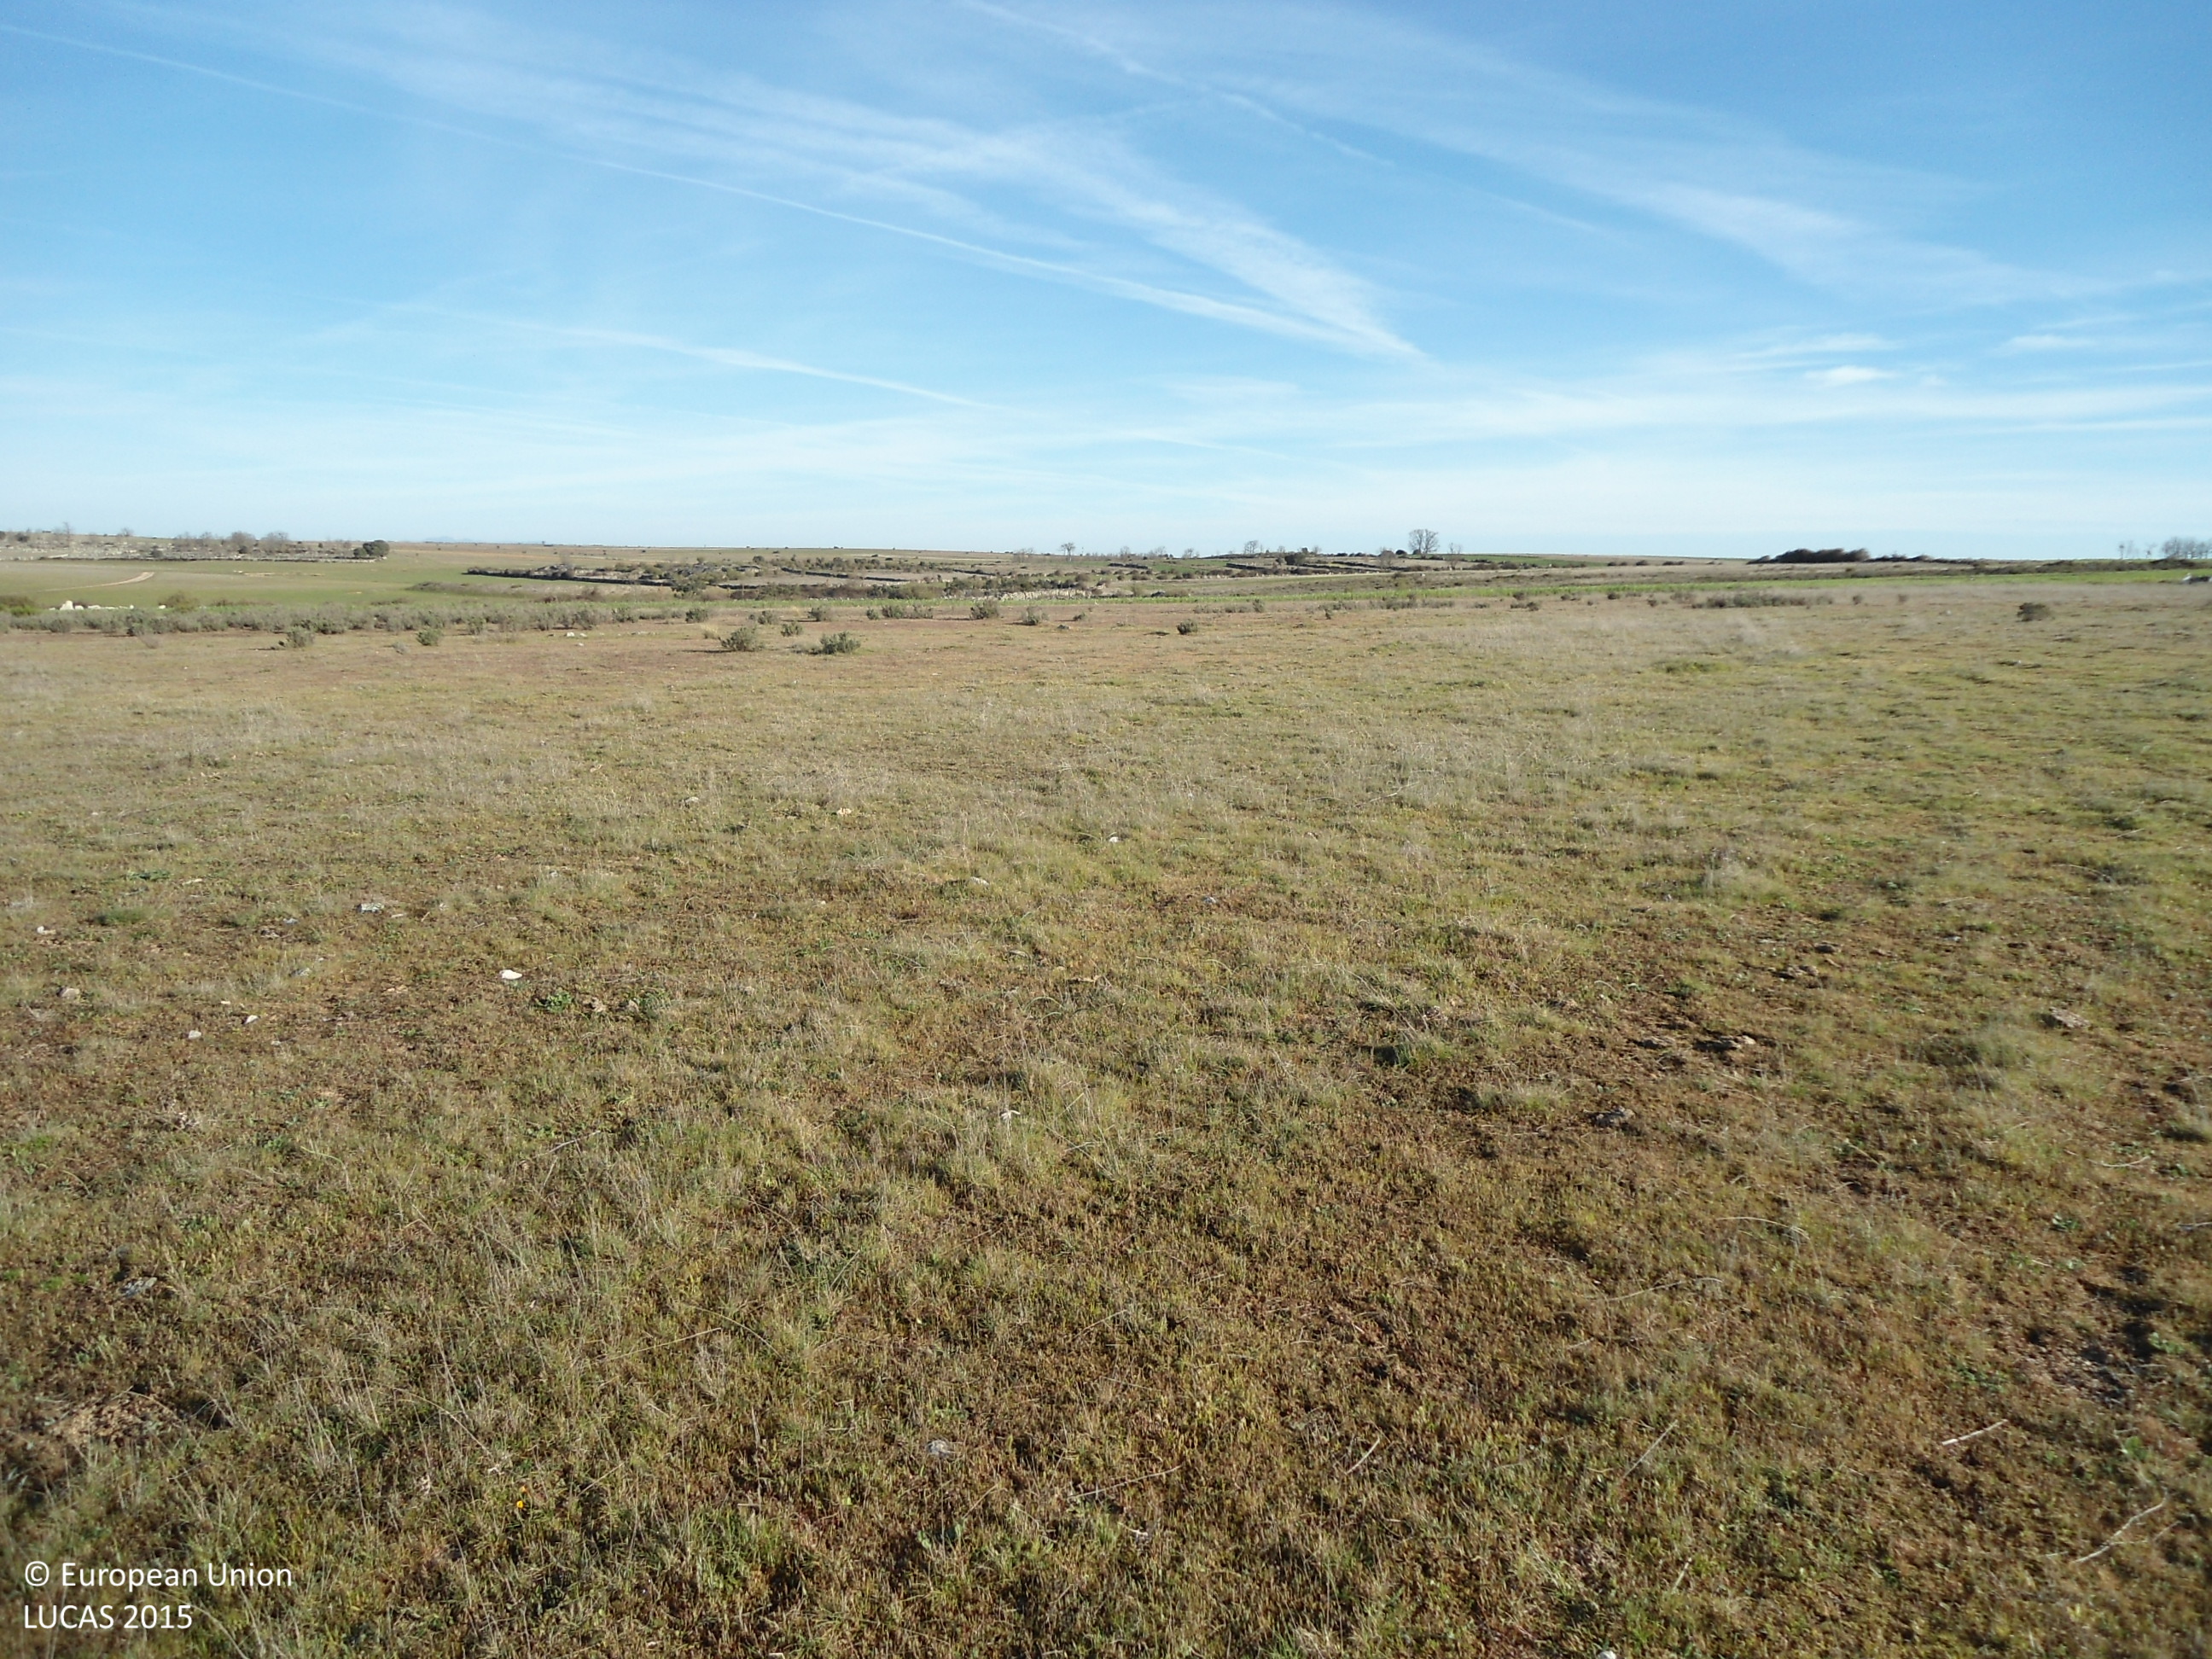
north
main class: Grassland
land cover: Grassland without tree/shrub cover
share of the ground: > 75 %
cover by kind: herbaceous plants 100 %
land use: Agriculture (excluding fallow land and kitchen gardens)
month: April
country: ES
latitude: 41.5481
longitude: -6.0499
